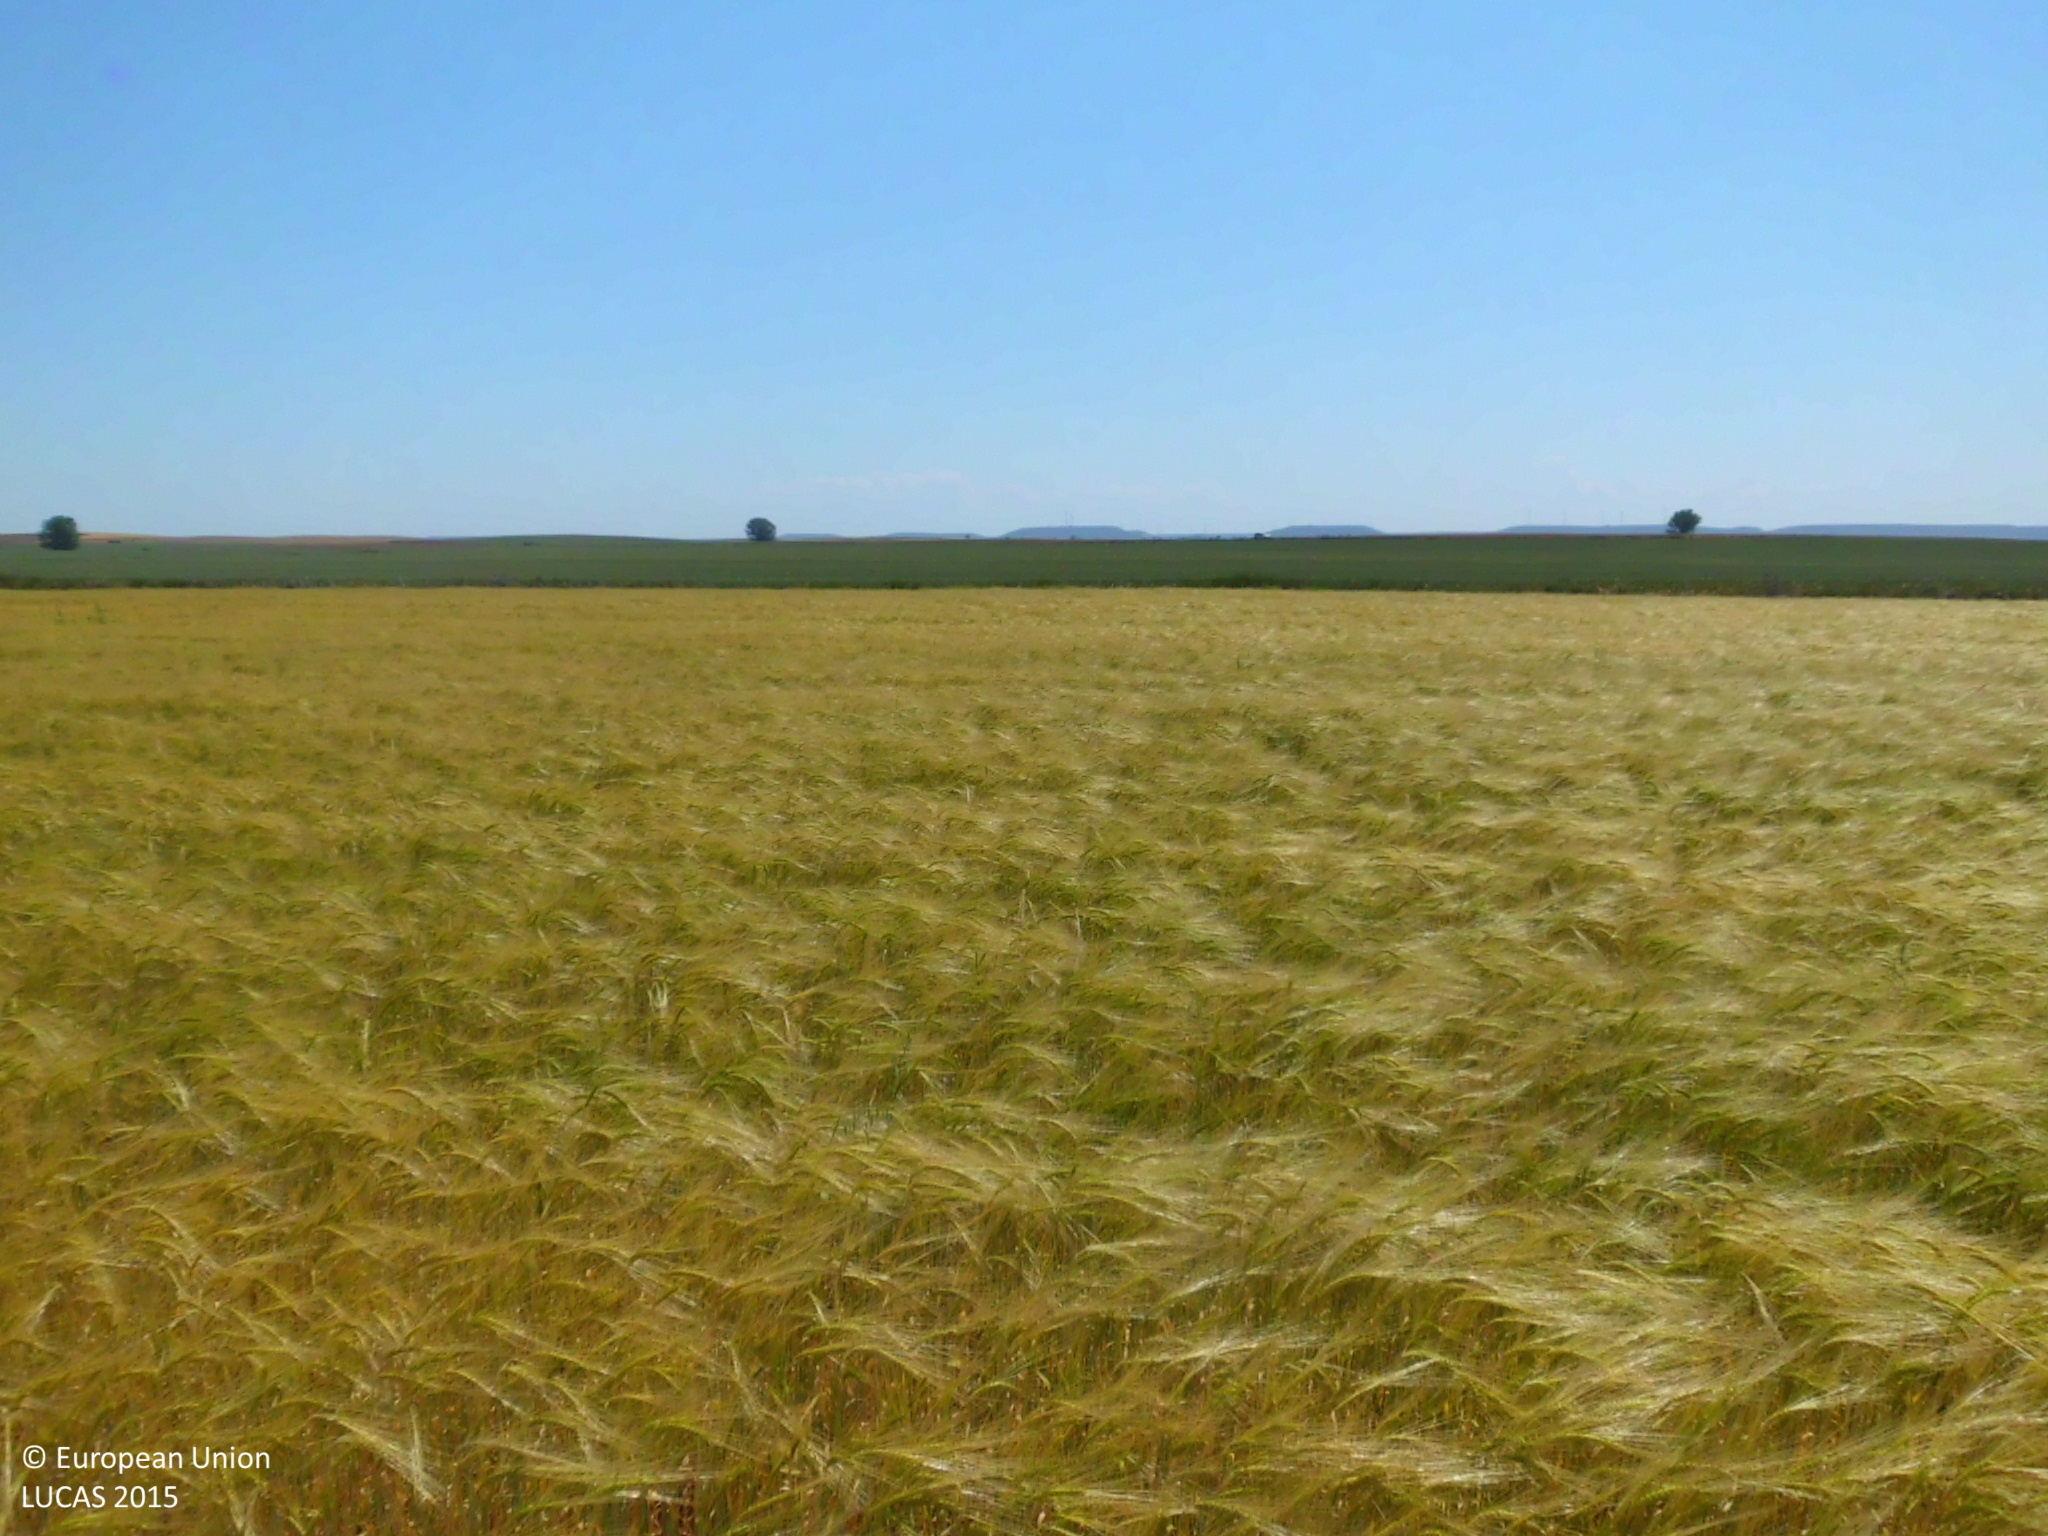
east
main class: Cropland
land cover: Barley
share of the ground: > 75 %
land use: Agriculture (excluding fallow land and kitchen gardens)
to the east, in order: Barley; Grass margins; Common wheat; Grass margins; Common wheat
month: June
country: ES
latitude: 42.3809
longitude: -4.1940
